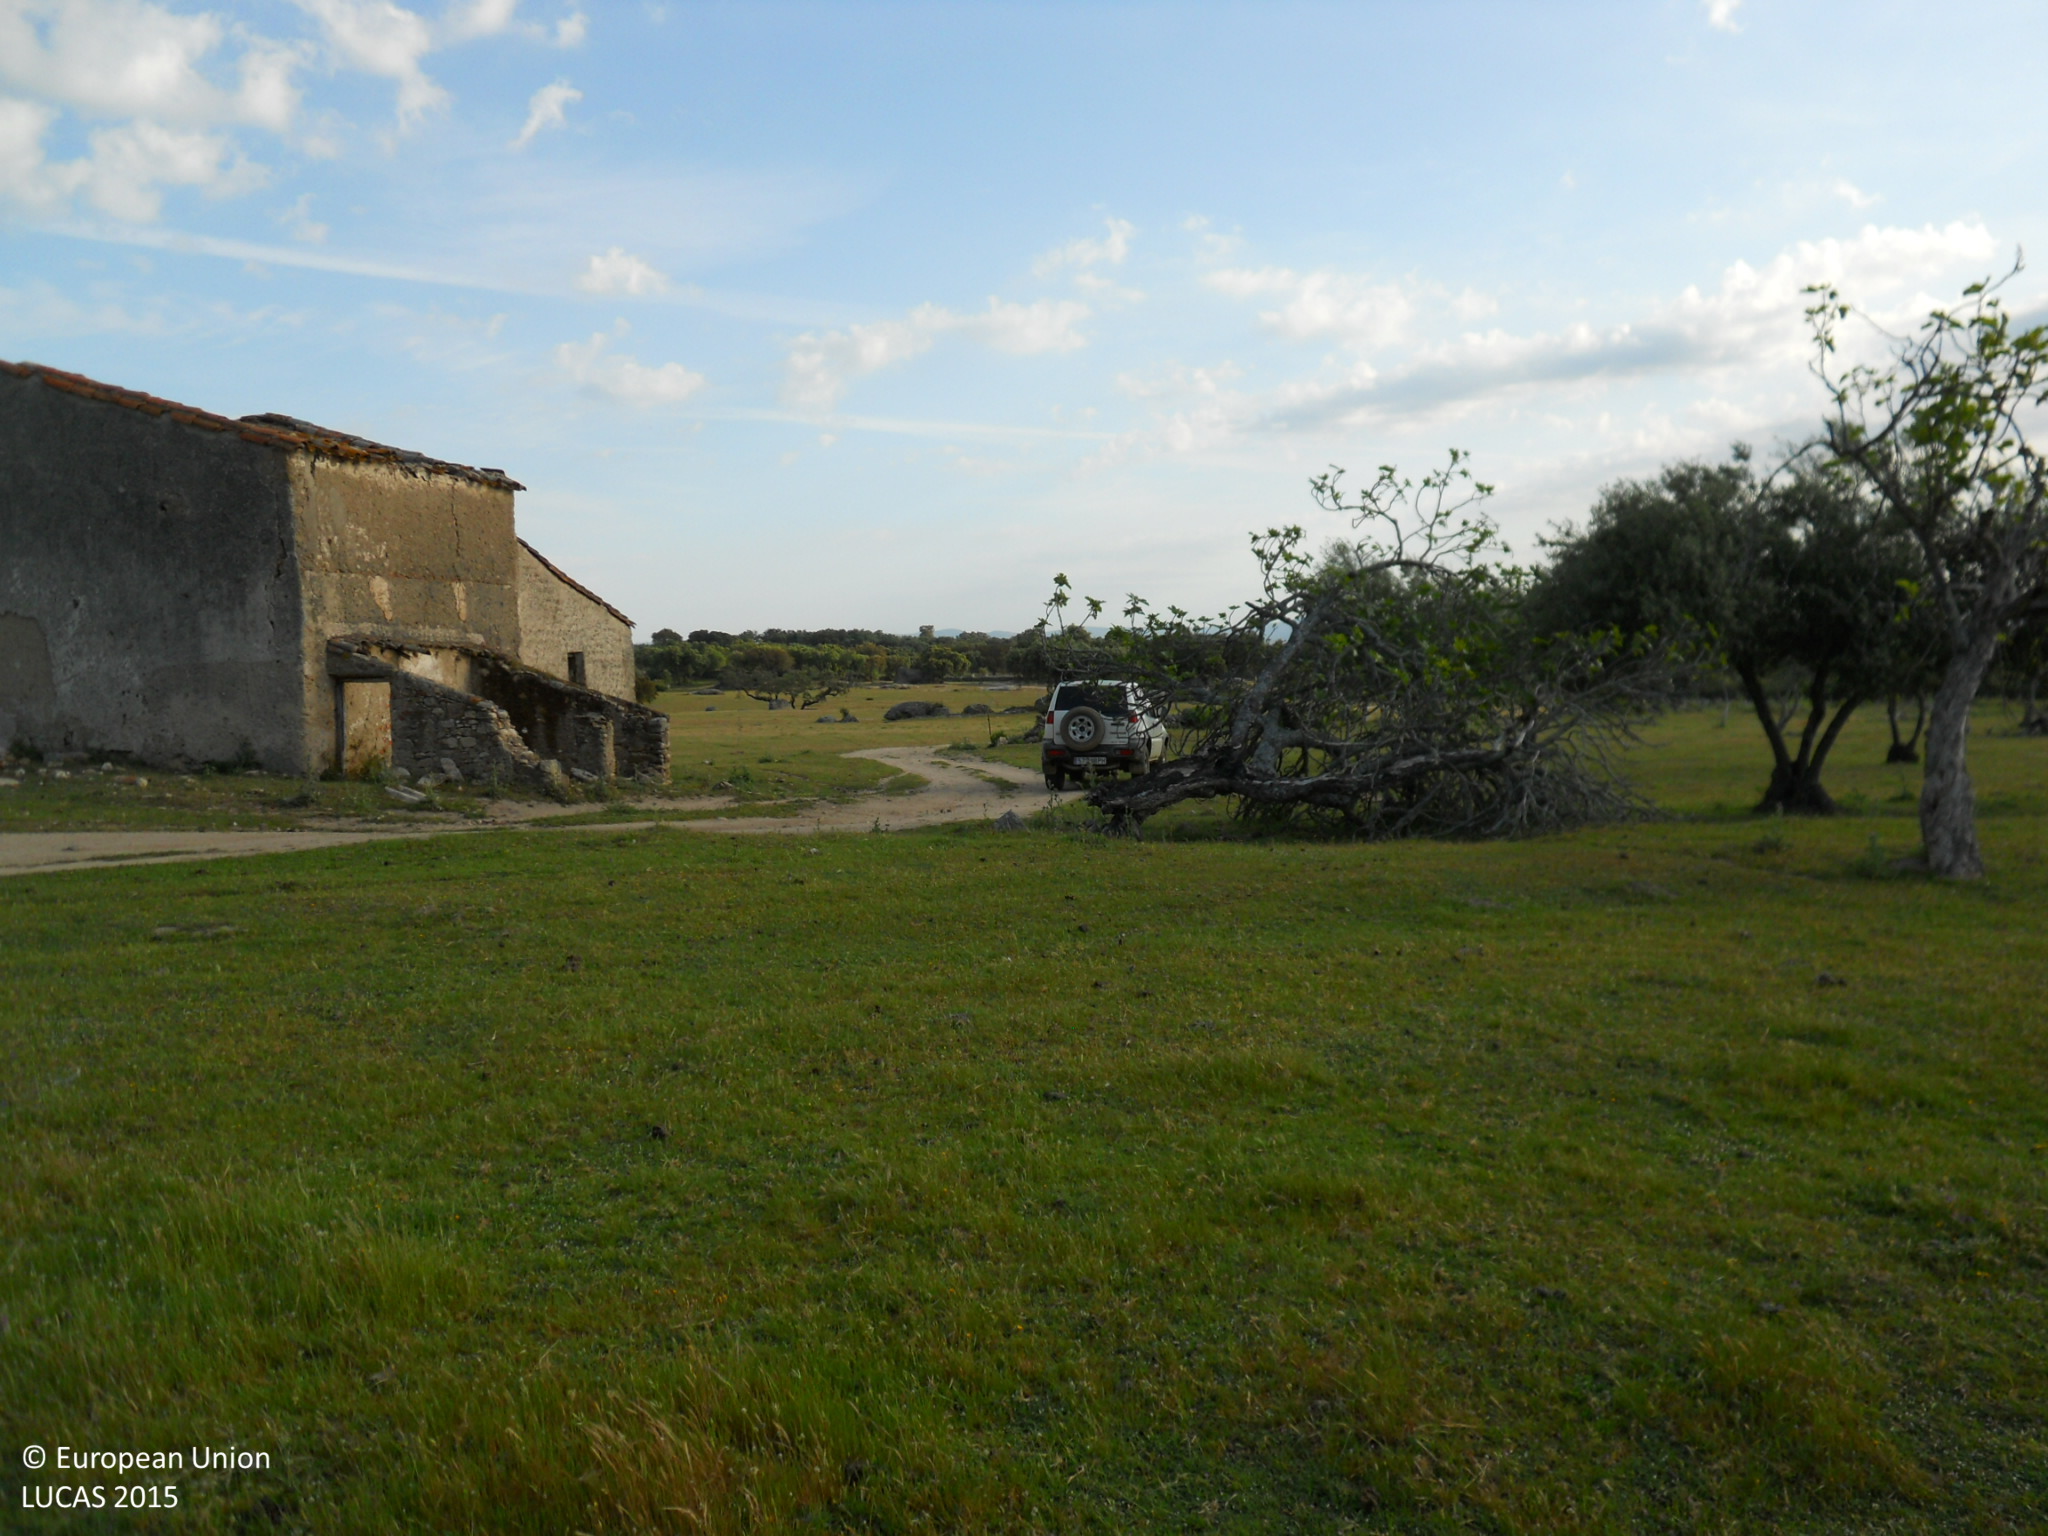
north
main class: Cropland
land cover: Other fruit trees and berries
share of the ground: < 10 %
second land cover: Spontaneously vegetated surfaces
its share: > 75 %
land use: Agriculture (excluding fallow land and kitchen gardens)
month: April
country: ES
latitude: 39.2185
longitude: -6.9748
